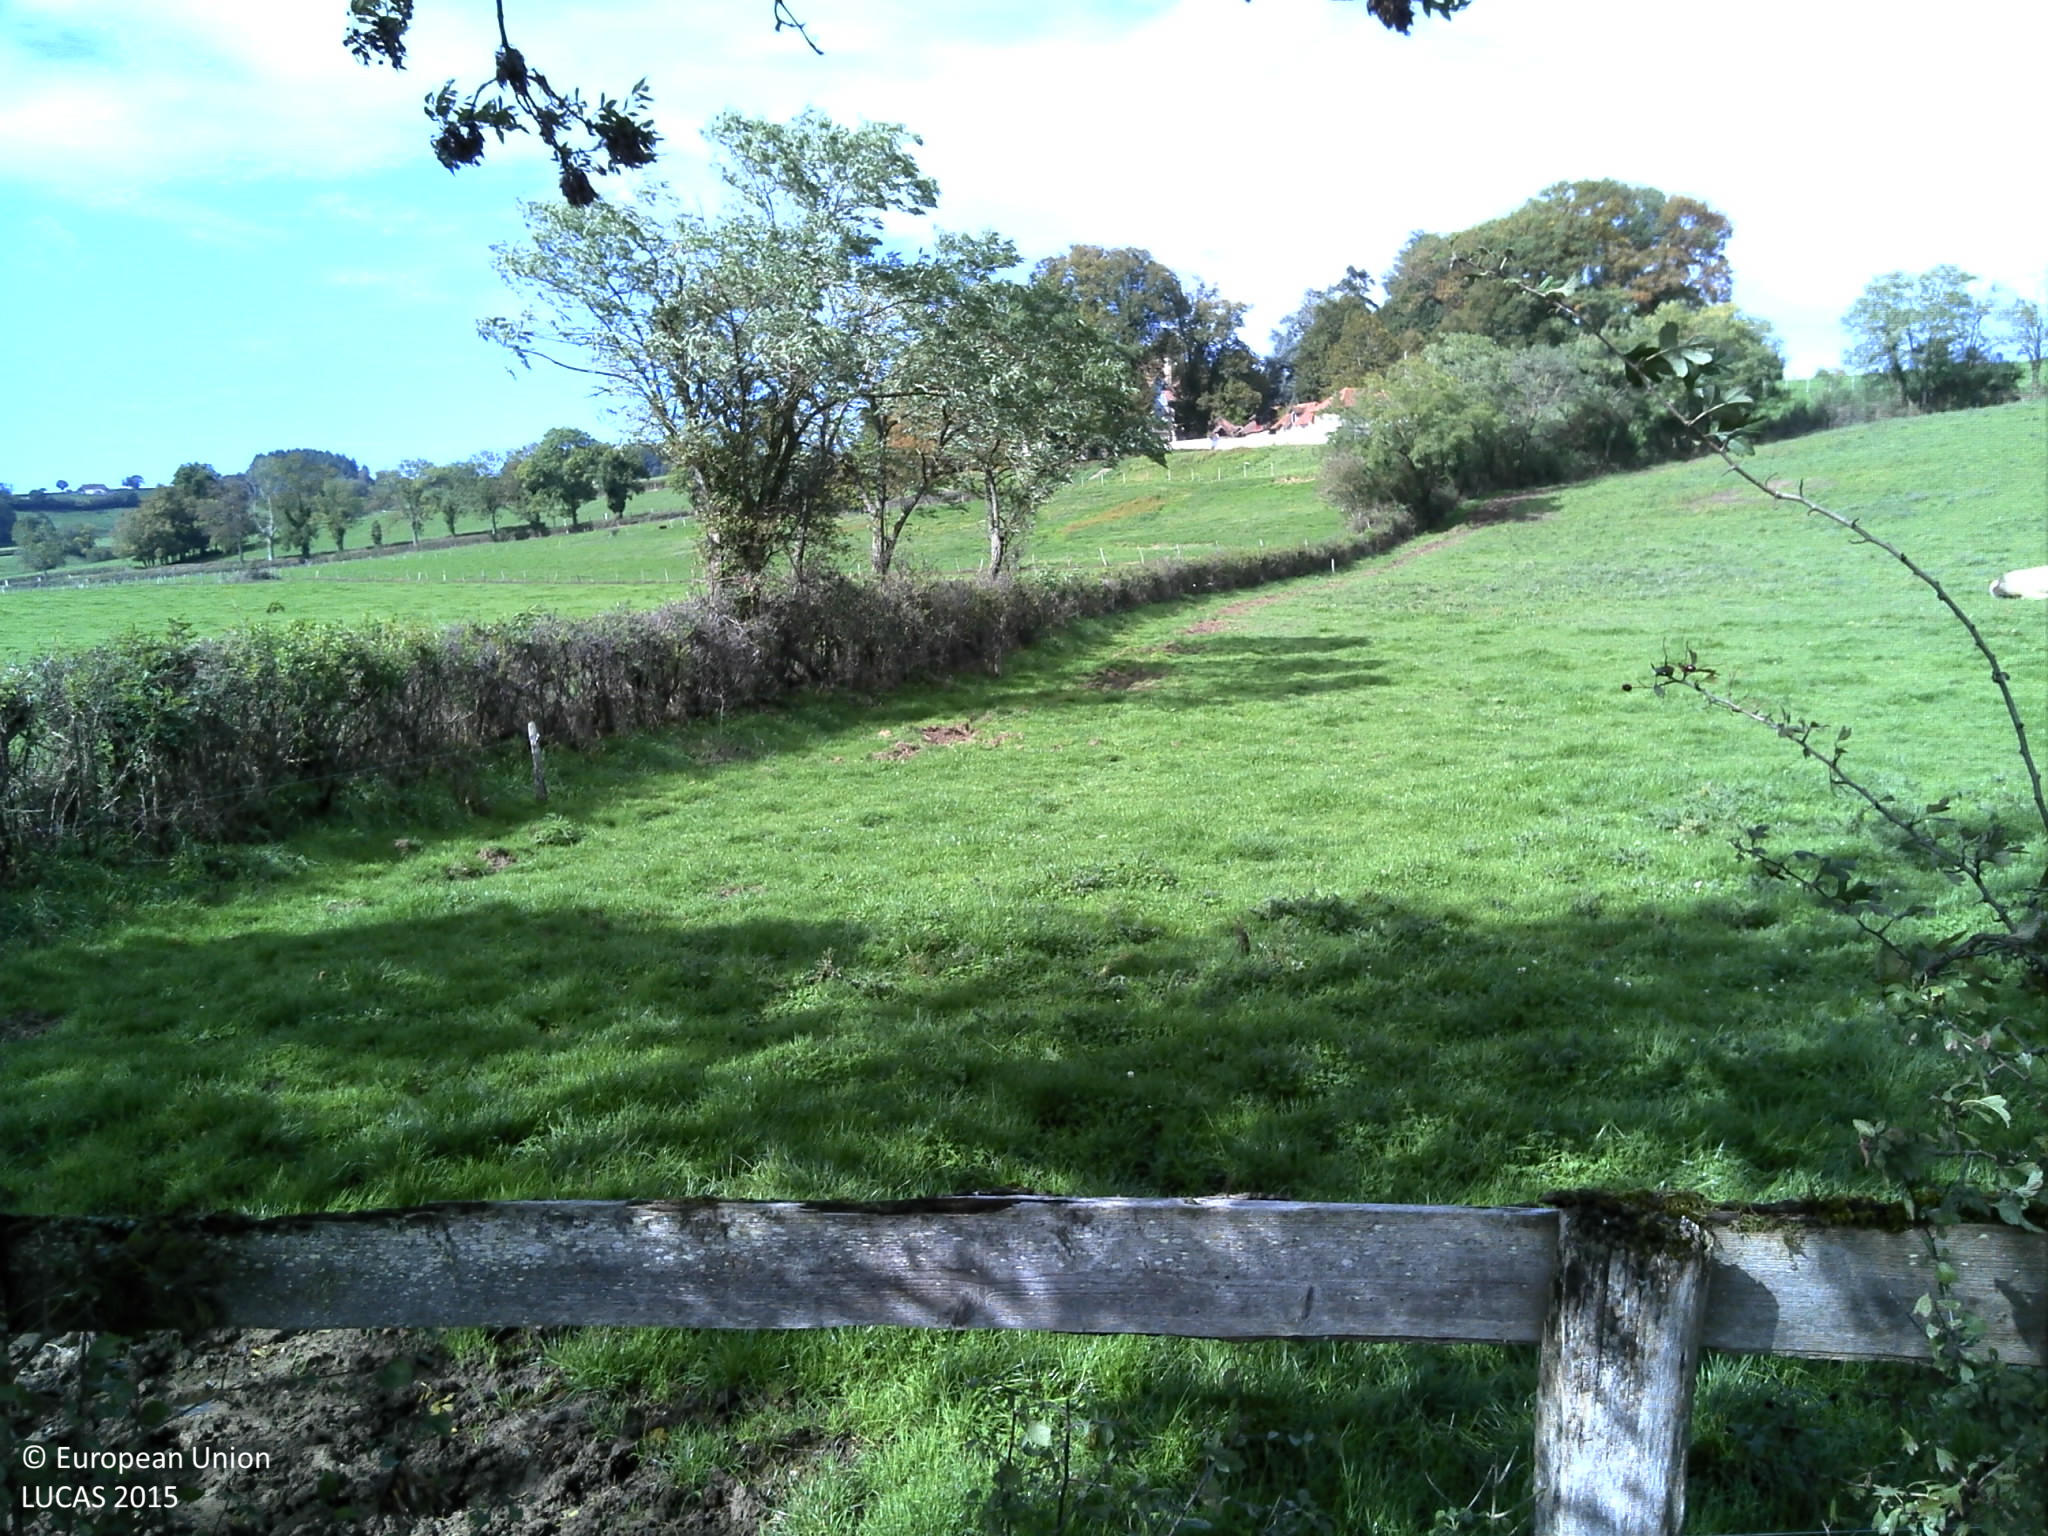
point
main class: Grassland
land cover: Grassland without tree/shrub cover
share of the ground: > 75 %
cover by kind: herbaceous plants 100 %
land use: Agriculture (excluding fallow land and kitchen gardens)
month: October
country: FR
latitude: 46.6194
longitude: 4.0583
